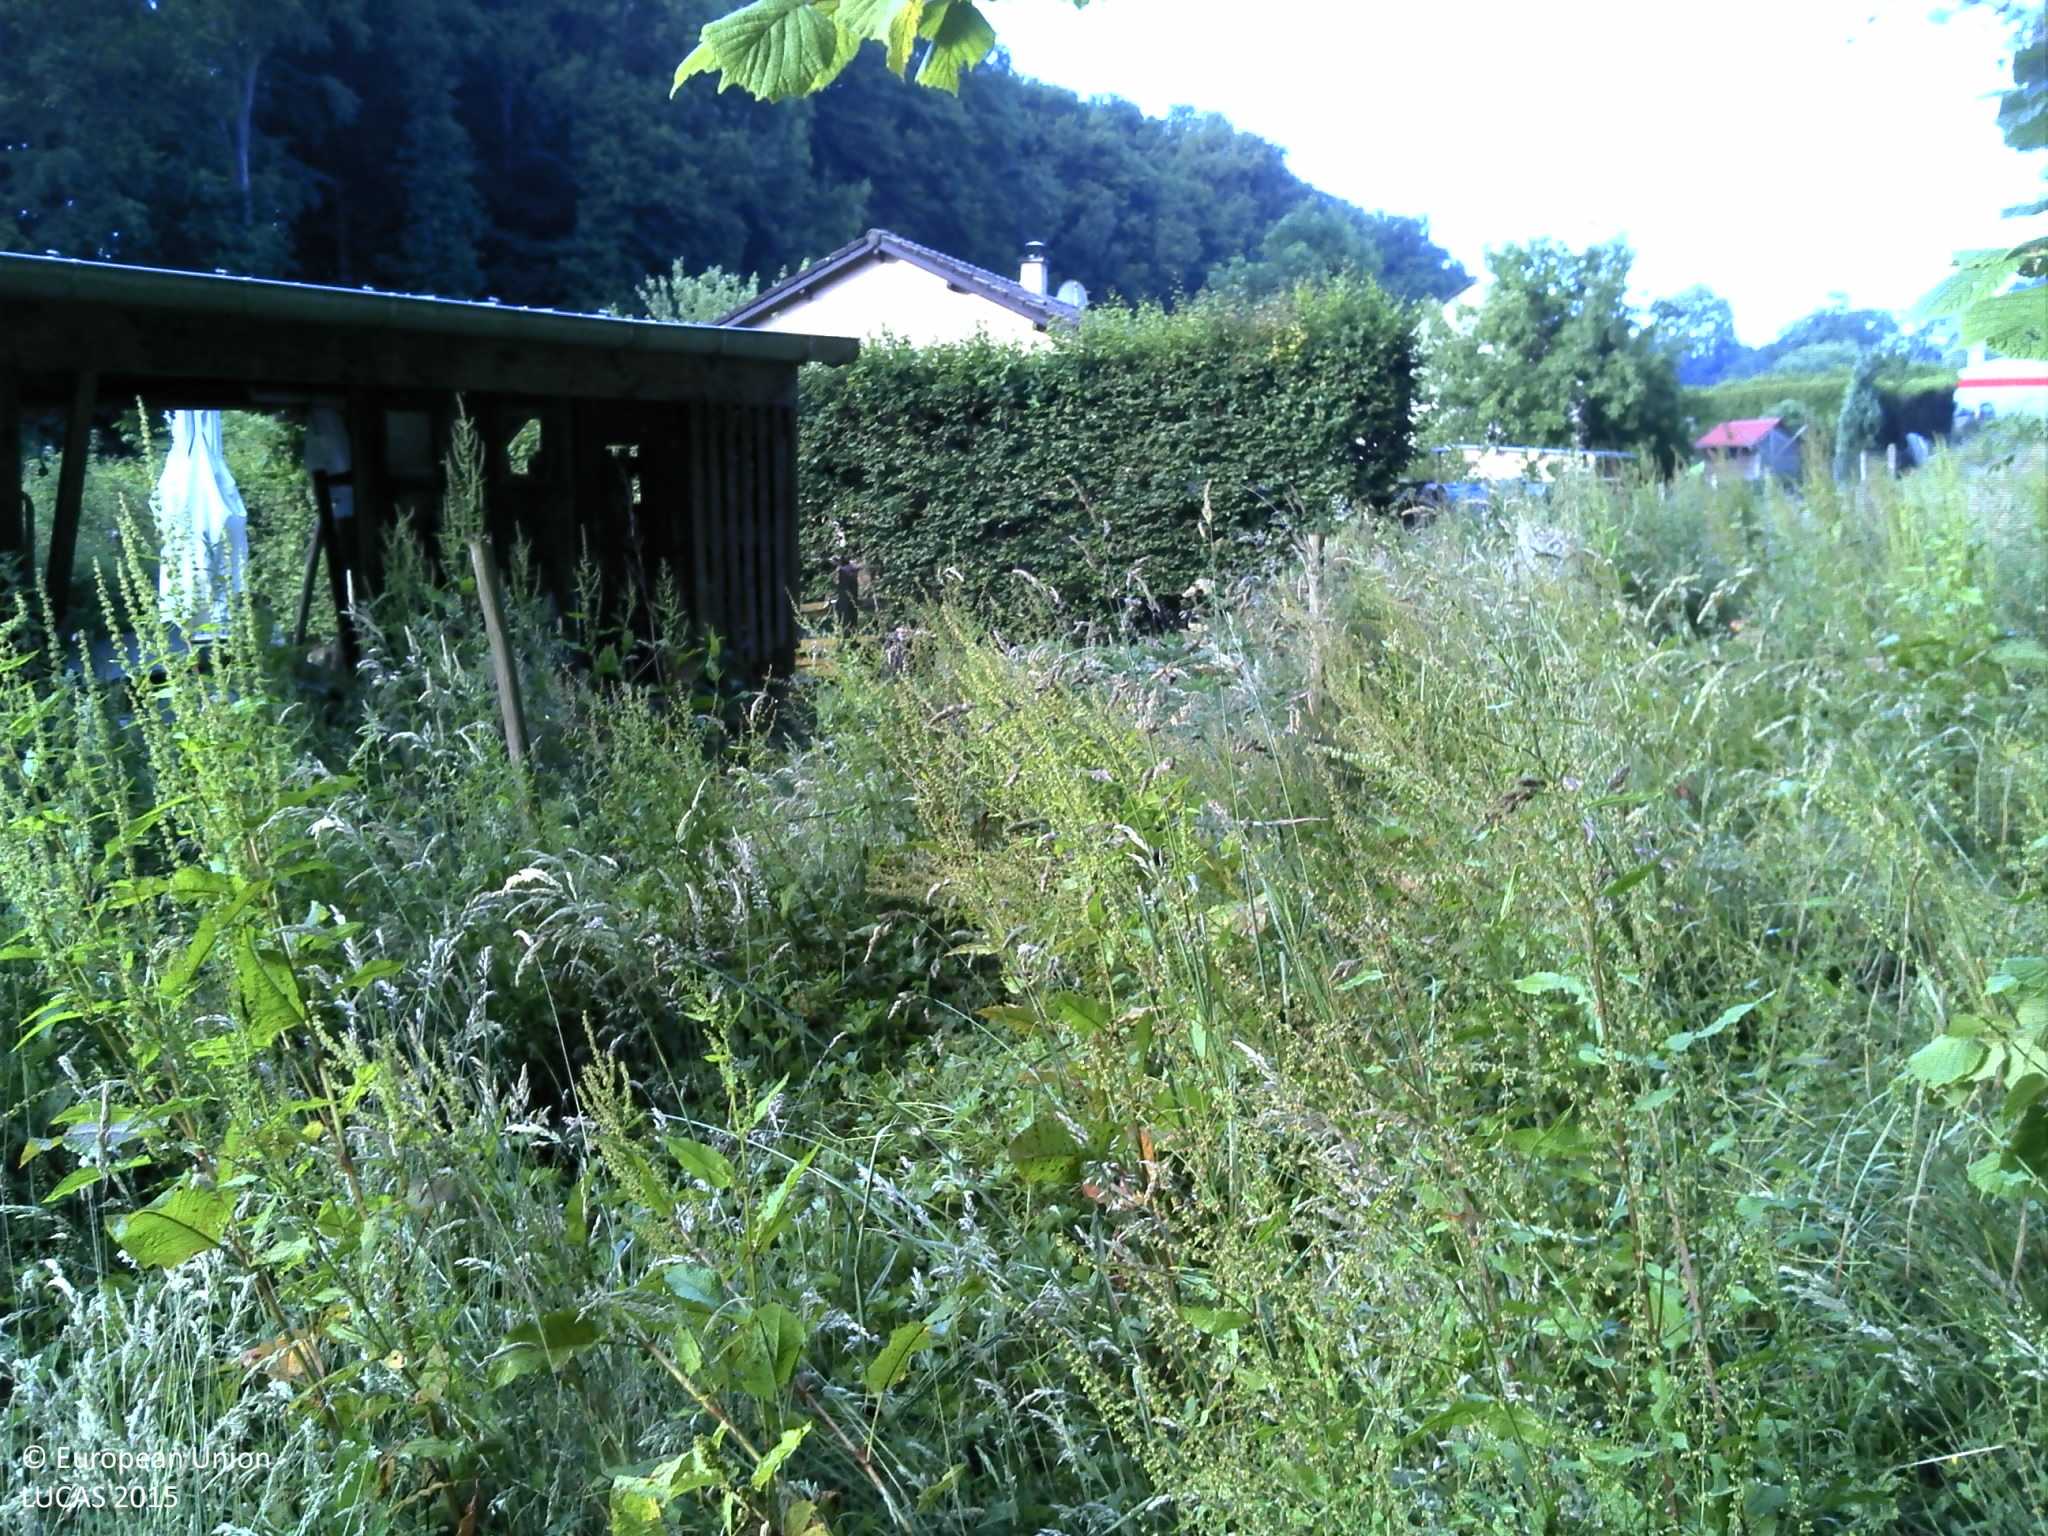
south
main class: Woodland
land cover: Broadleaved woodland
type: acidophilous oak and oak-birch forest
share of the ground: 50 - 75 %
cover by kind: broadleaved forest trees 70 %, herbaceous plants 30 %
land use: Forestry
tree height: > 5 m
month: June
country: FR
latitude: 49.7150
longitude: 0.9483
